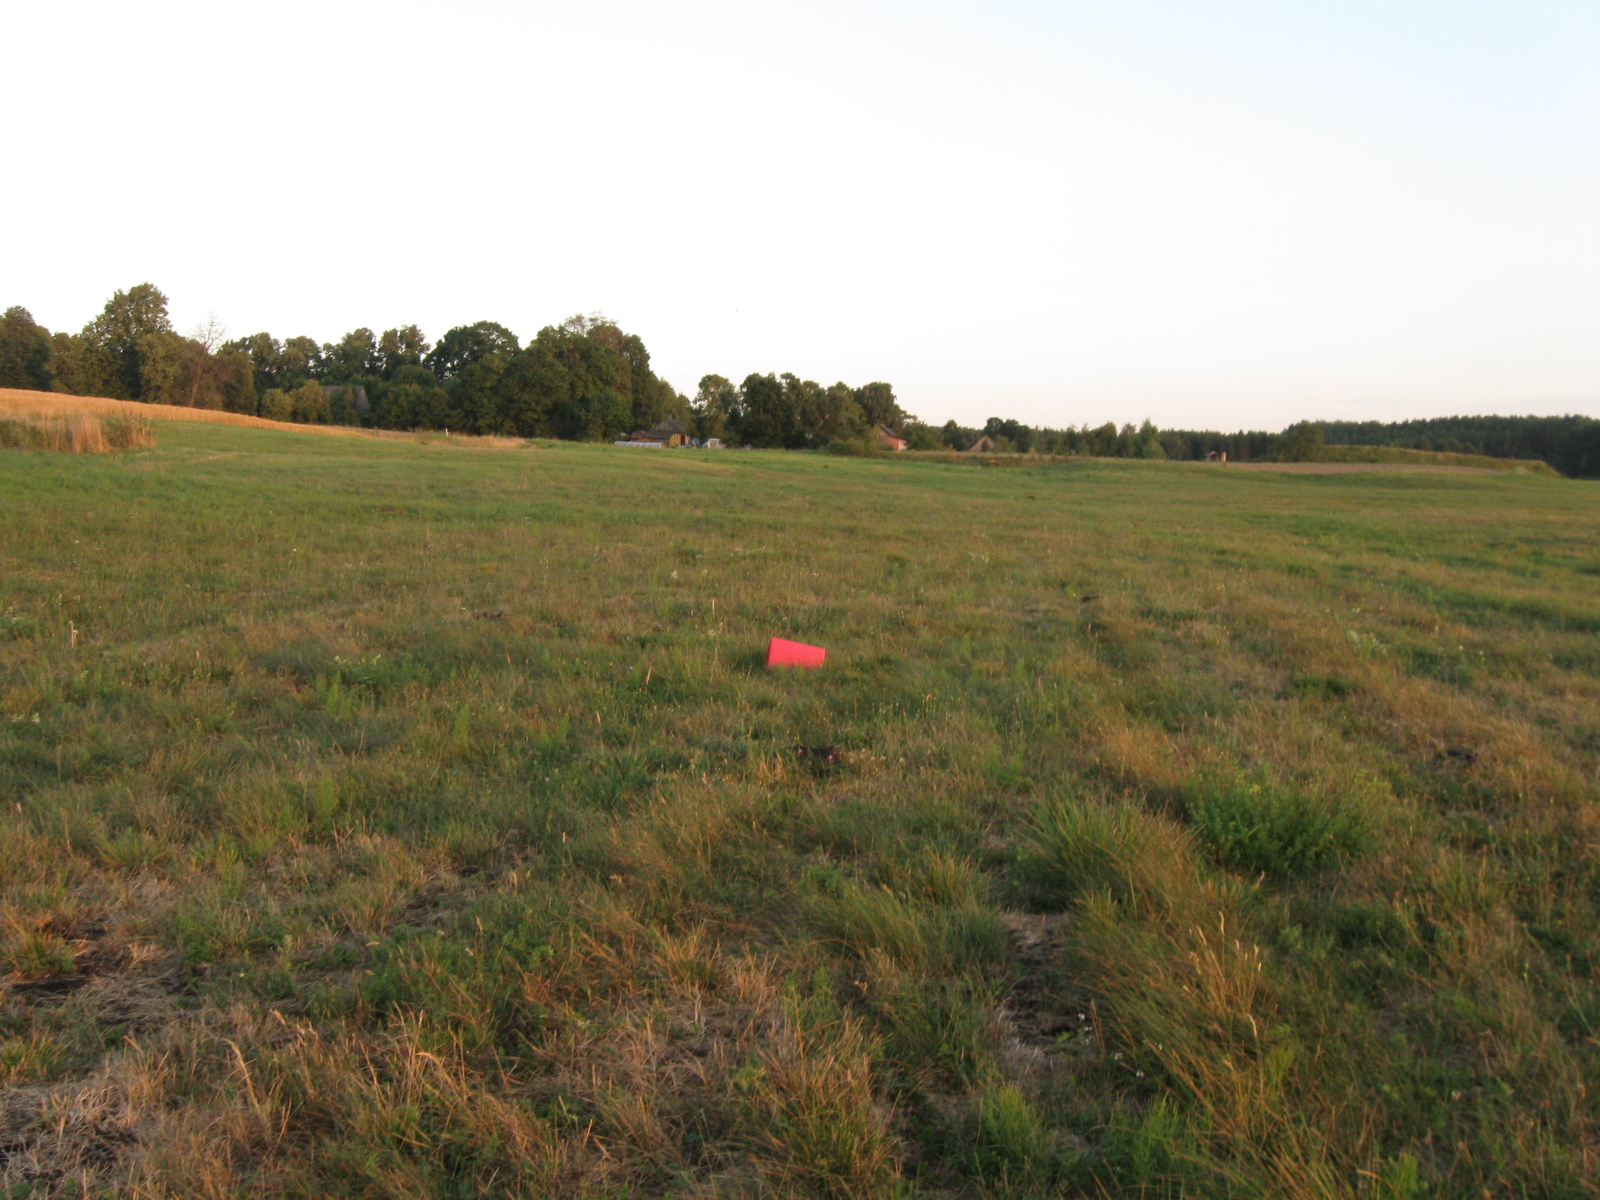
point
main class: Grassland
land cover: Grassland without tree/shrub cover
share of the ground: > 75 %
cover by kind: herbaceous plants 90 %, unconsolidated bare surface 10 %
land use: Agriculture (excluding fallow land and kitchen gardens)
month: July
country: LT
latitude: 54.2634
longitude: 23.5164
